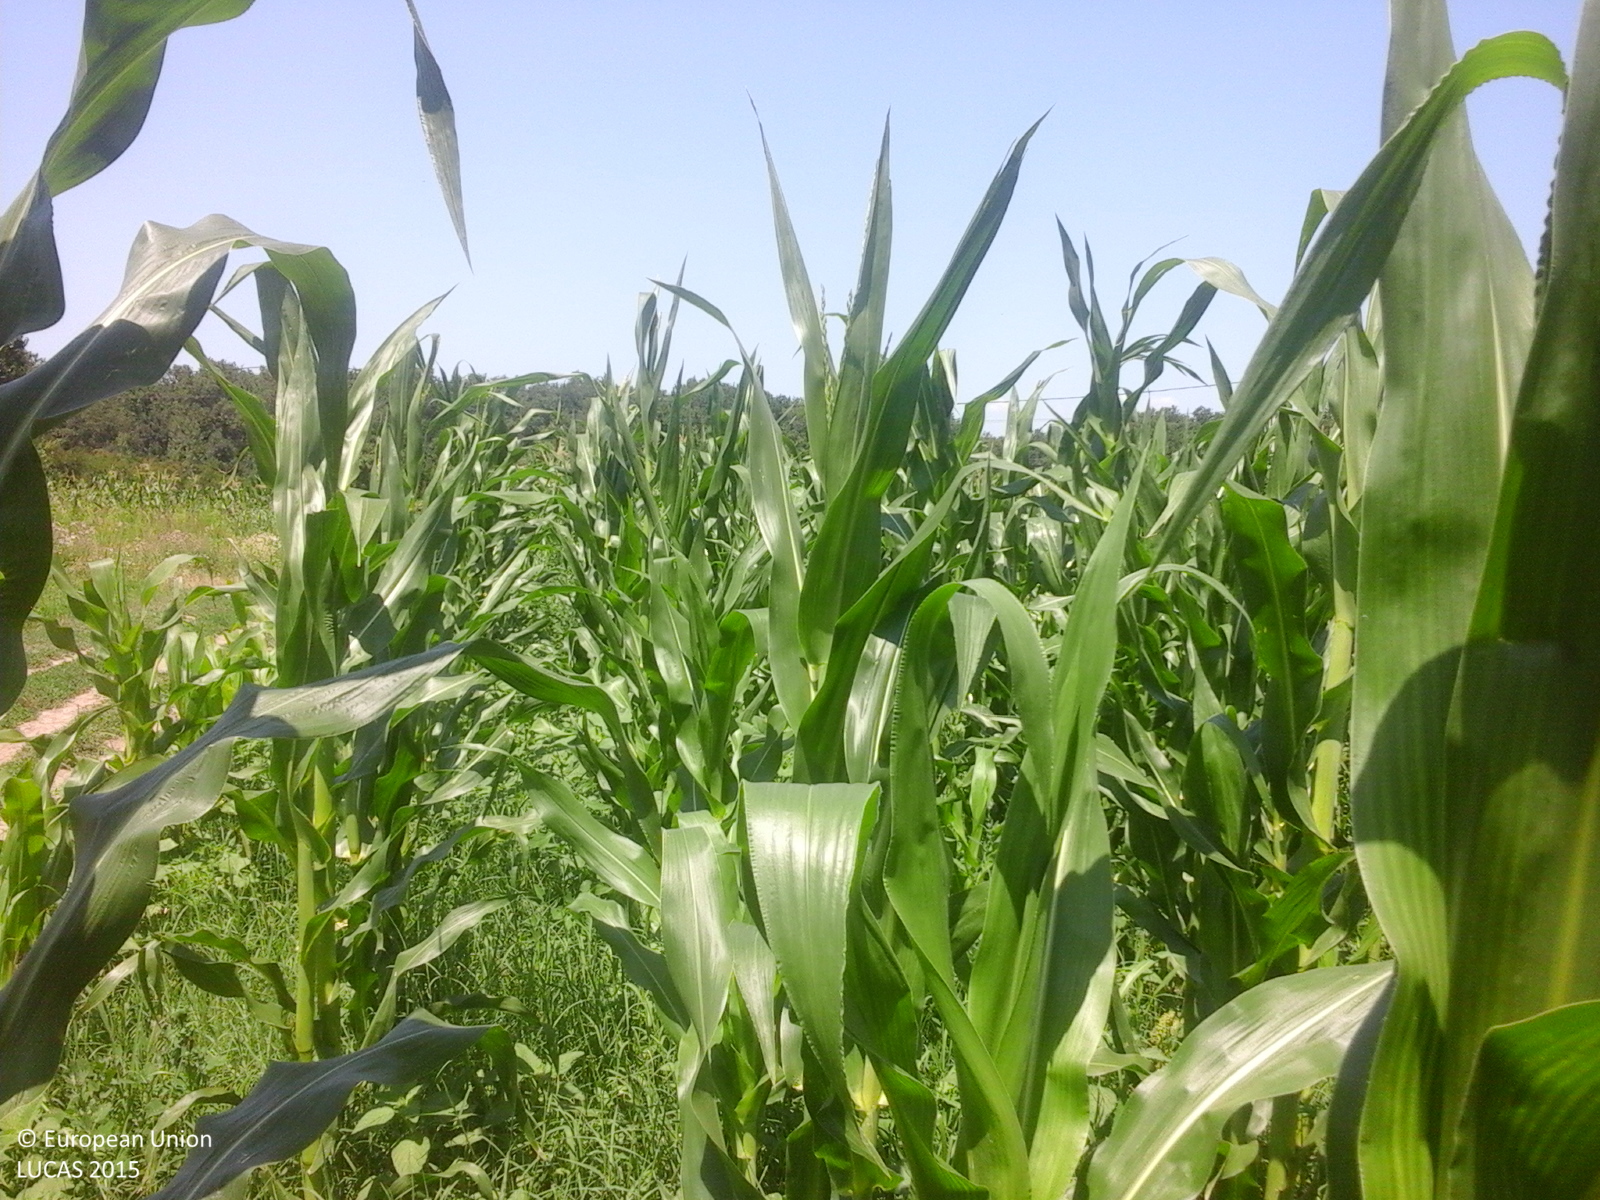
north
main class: Cropland
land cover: Maize
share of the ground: > 75 %
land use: Agriculture (excluding fallow land and kitchen gardens)
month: July
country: RO
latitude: 44.2431
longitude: 24.3537
